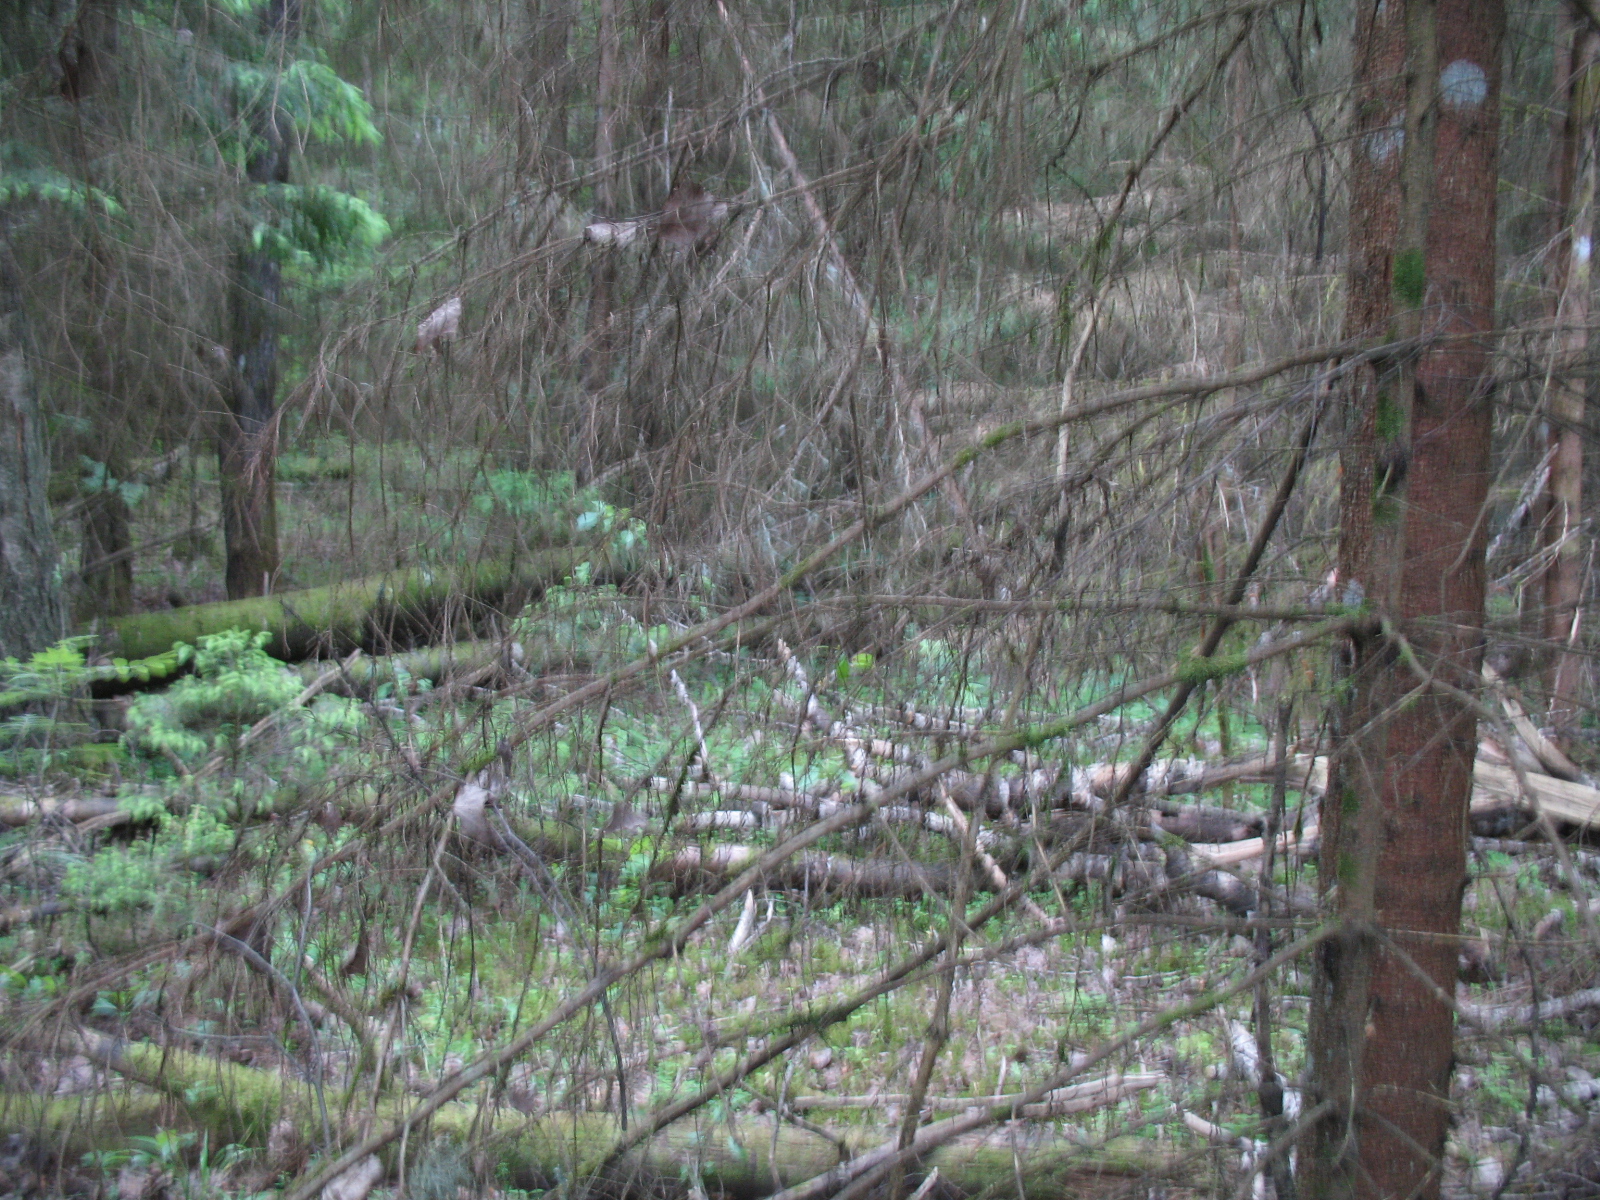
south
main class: Woodland
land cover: Spruce dominated mixed woodland
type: hemiboreal forest and nemoral coniferous forest and mixed broadleaved-coniferous forest
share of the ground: > 75 %
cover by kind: coniferous forest trees 50 %, broadleaved forest trees 45 %, herbaceous plants 5 %
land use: Forestry
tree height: > 5 m
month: June
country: LV
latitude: 56.7637
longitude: 23.8720
